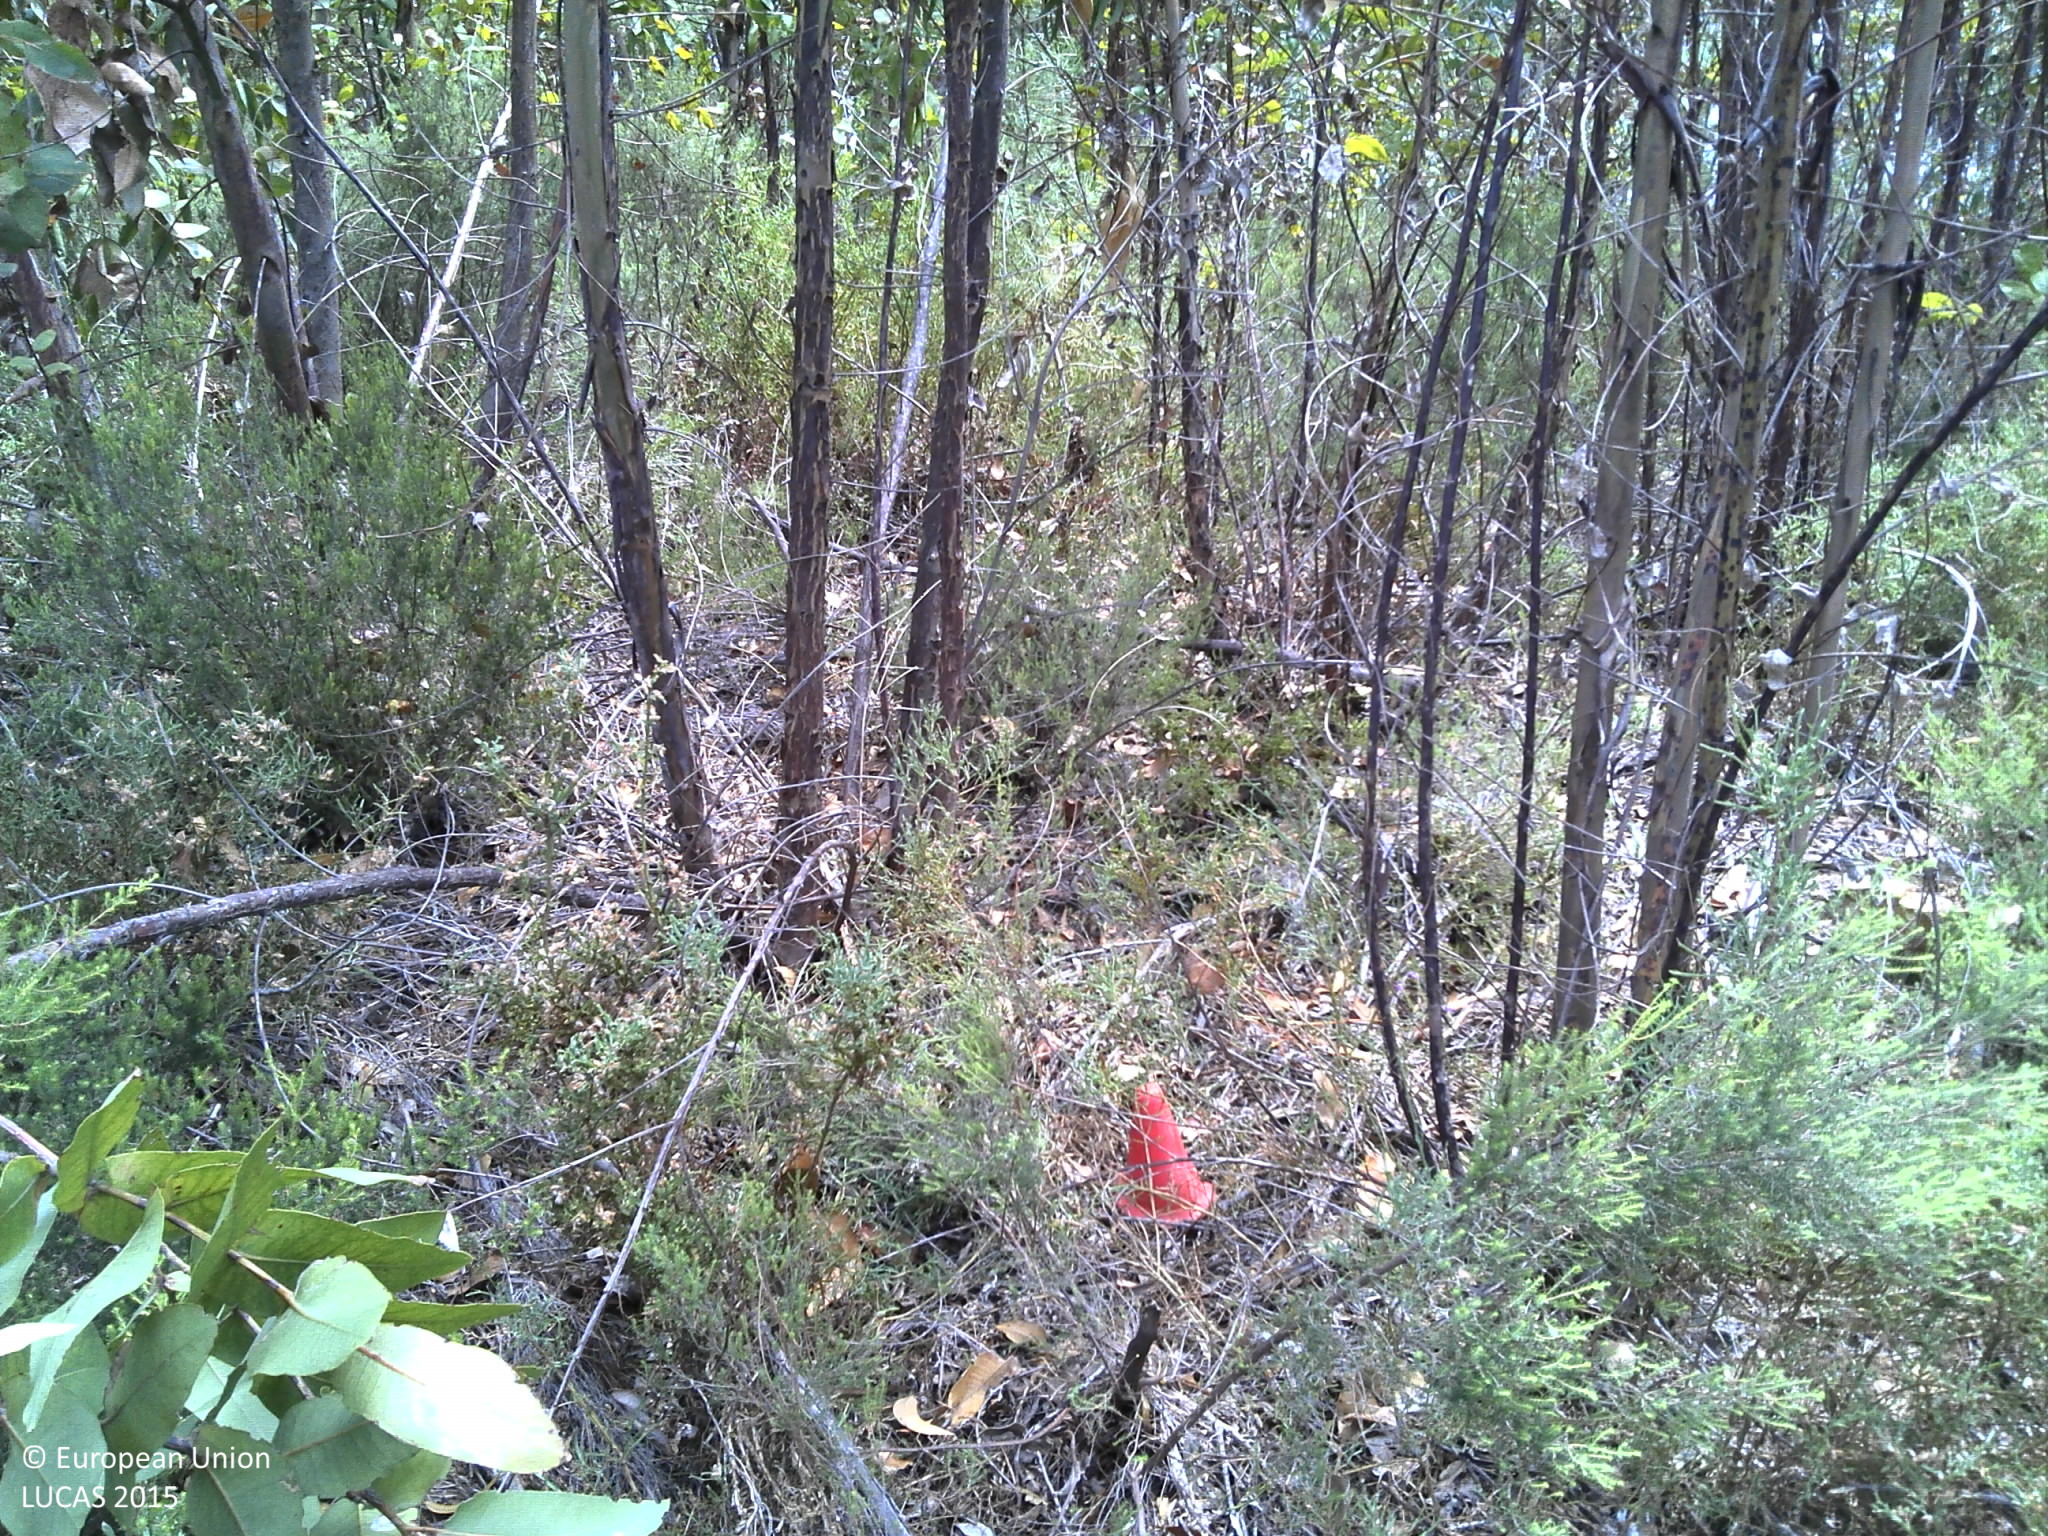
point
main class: Woodland
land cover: Pine dominated coniferous woodland
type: coniferous forest of the mediterranean region
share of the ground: 25 - 50 %
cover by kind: shrubs 50 %, coniferous forest trees 30 %, unconsolidated bare surface 20 %
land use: Forestry
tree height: > 5 m
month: July
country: PT
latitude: 39.9034
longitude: -7.8776
